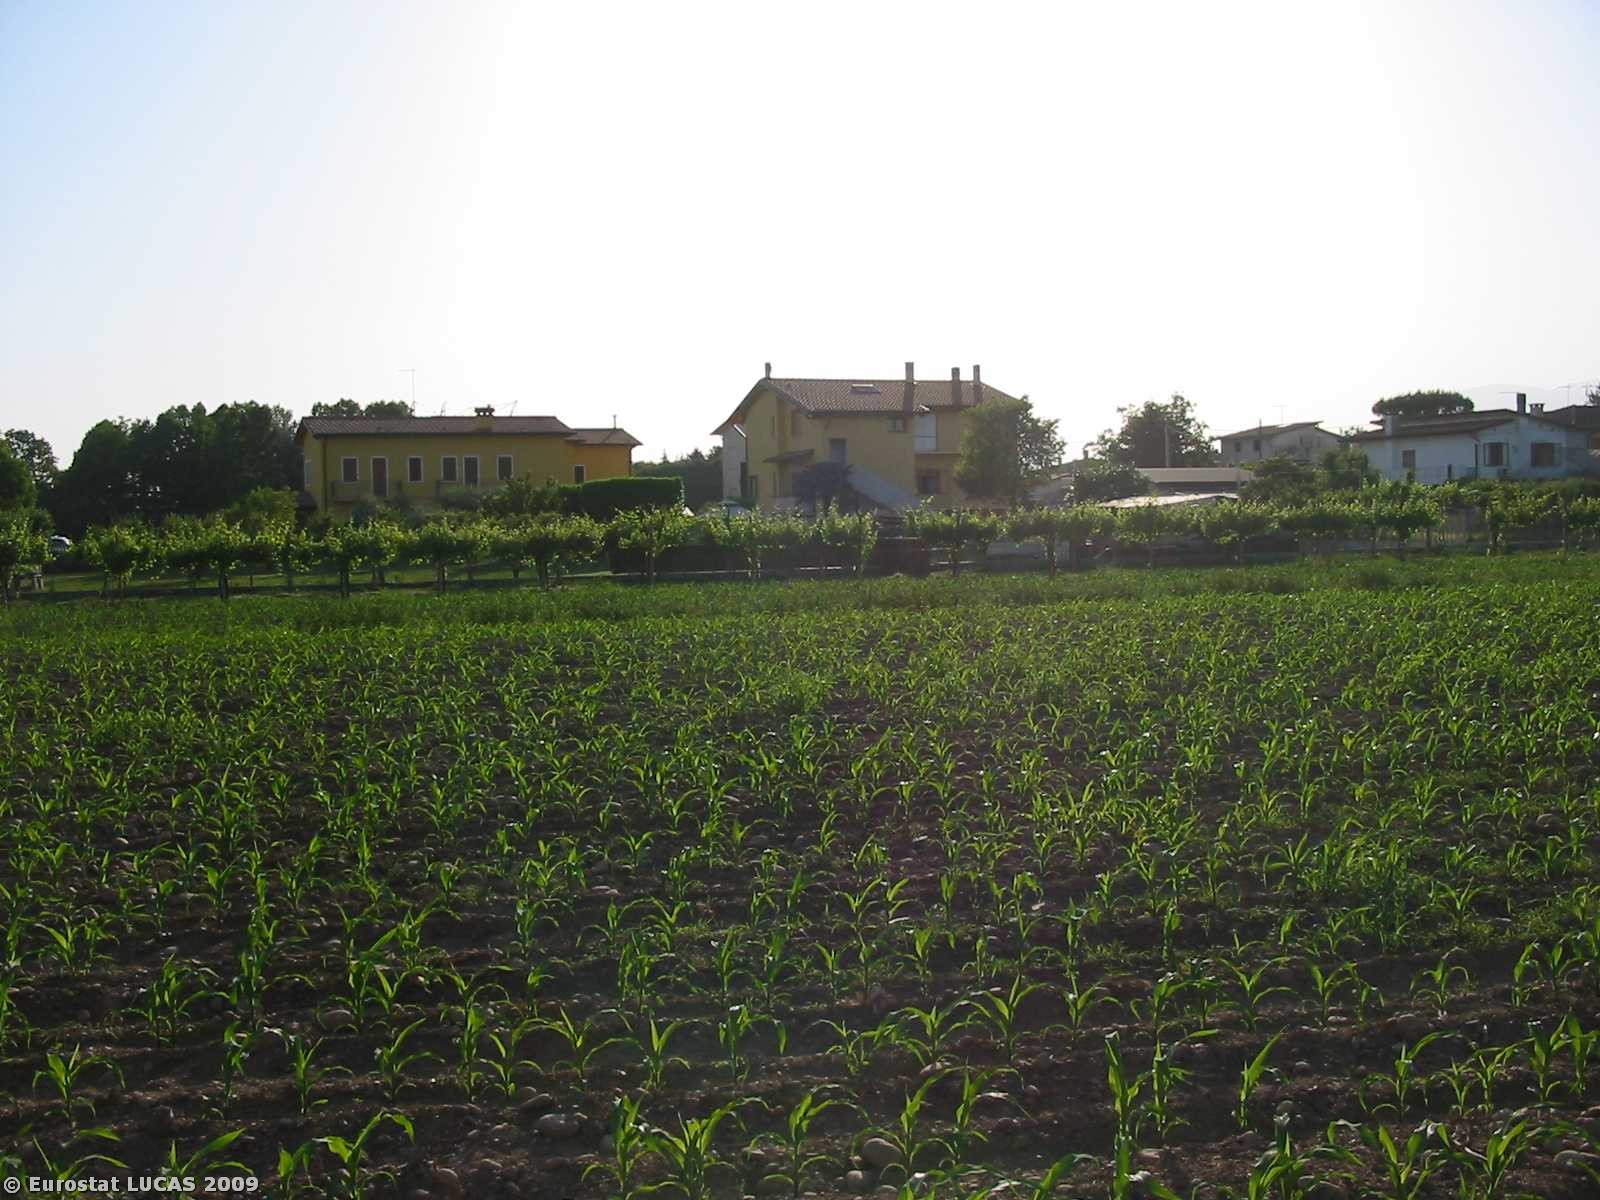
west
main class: Cropland
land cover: Vineyards
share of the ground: 10 - 25 %
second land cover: Grassland with sparse tree/shrub cover
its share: > 75 %
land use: Agriculture (excluding fallow land and kitchen gardens)
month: May
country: IT
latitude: 45.7069
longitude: 11.7058
